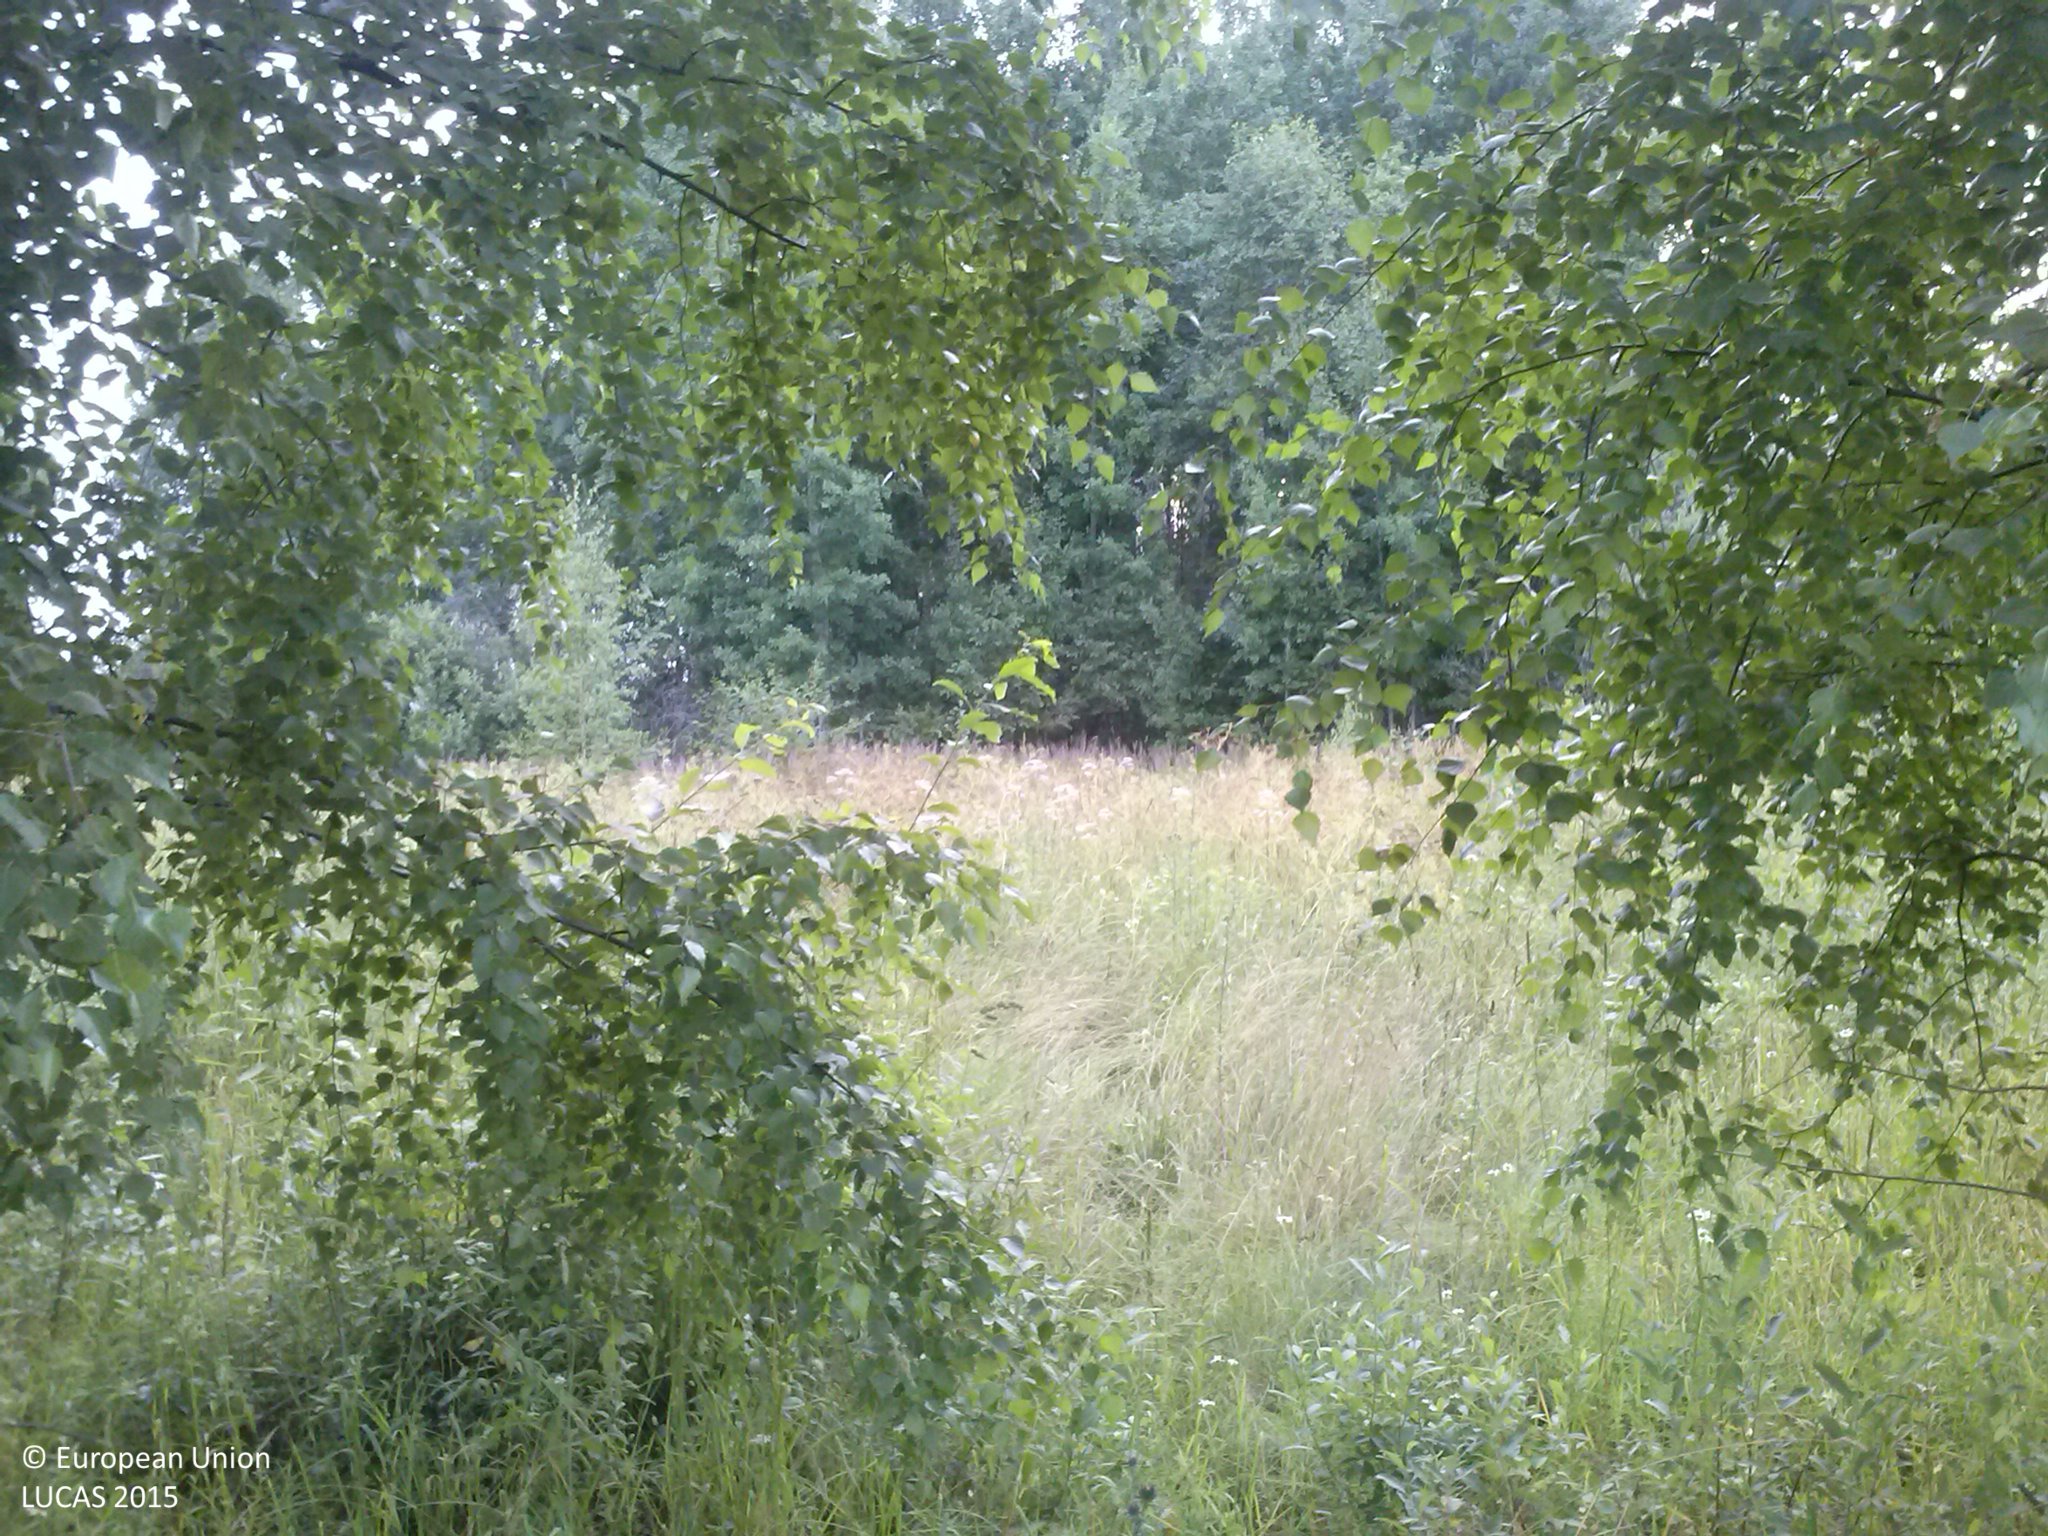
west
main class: Woodland
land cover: Broadleaved woodland
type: non-riverine alder, birch or aspen forest
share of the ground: 50 - 75 %
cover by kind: broadleaved forest trees 60 %, herbaceous plants 30 %
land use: Forestry
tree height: > 5 m
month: July
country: LV
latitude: 56.6694
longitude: 27.0870
